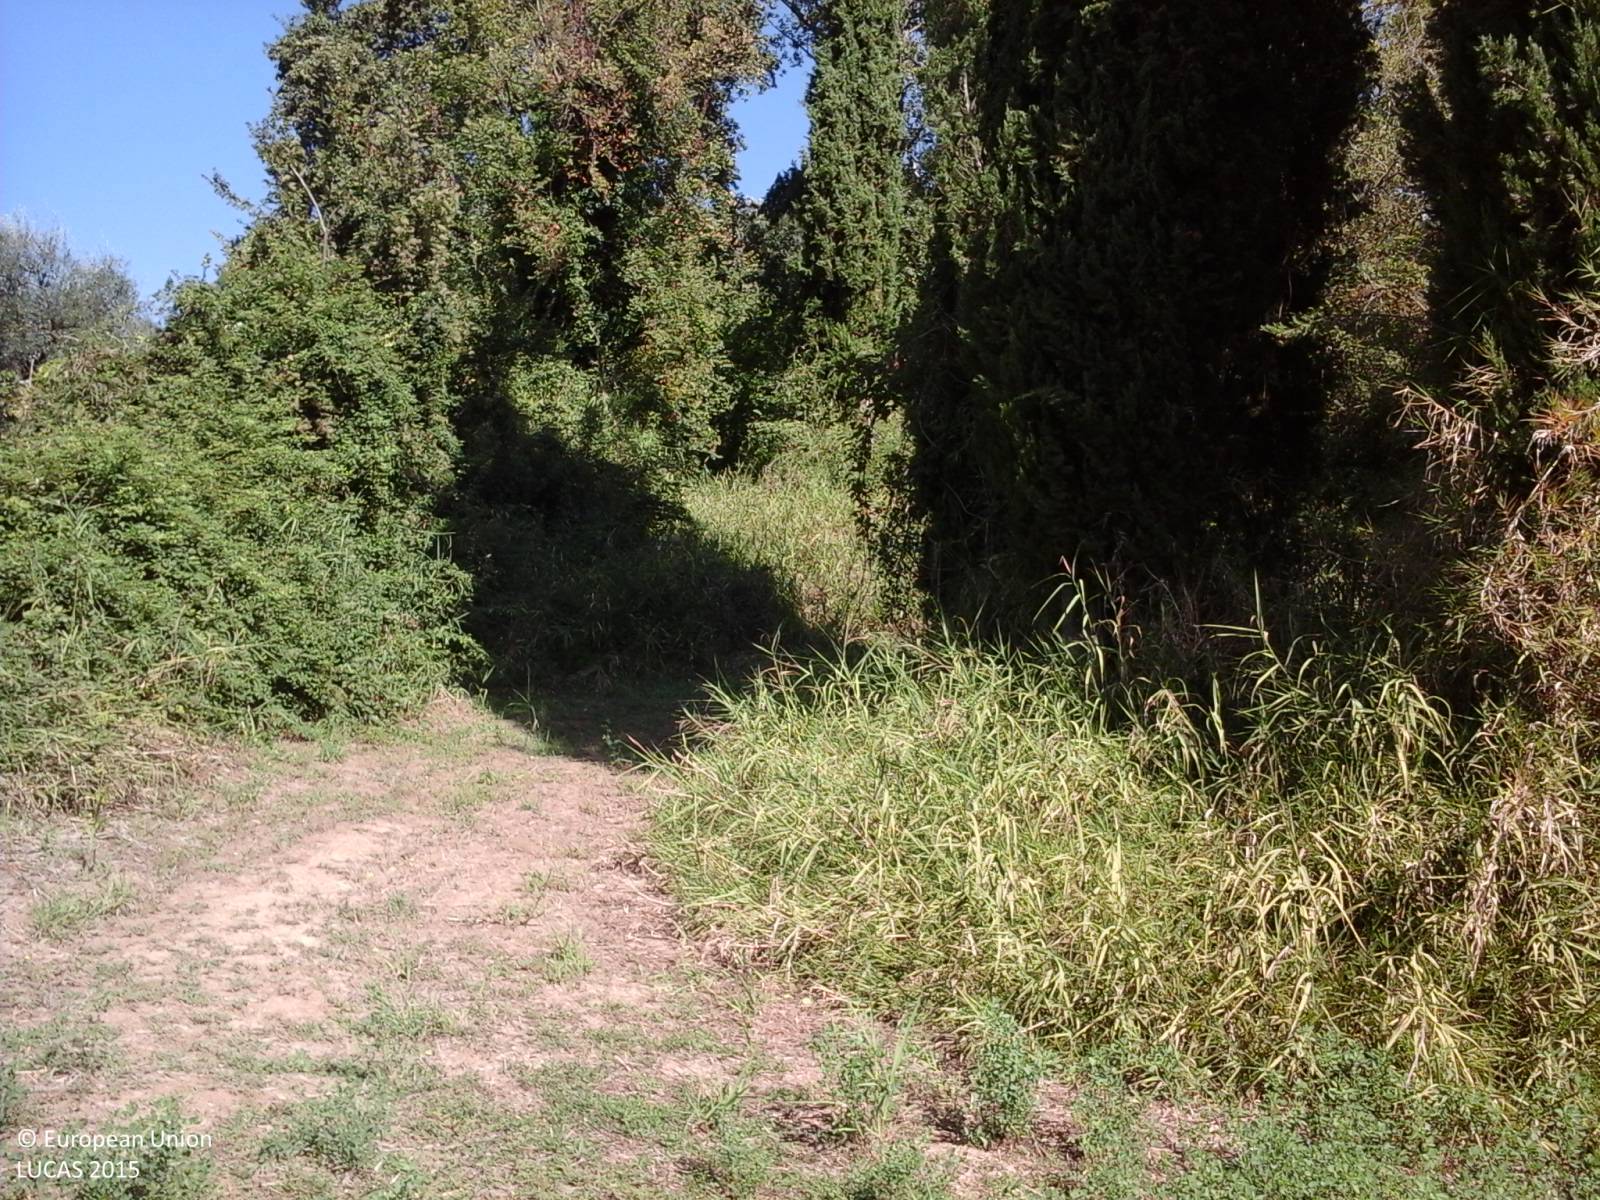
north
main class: Shrubland
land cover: Shrubland without tree cover
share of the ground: > 75 %
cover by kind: shrubs 100 %
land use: Agriculture (excluding fallow land and kitchen gardens)
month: September
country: IT
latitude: 42.2960
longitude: 12.5747
